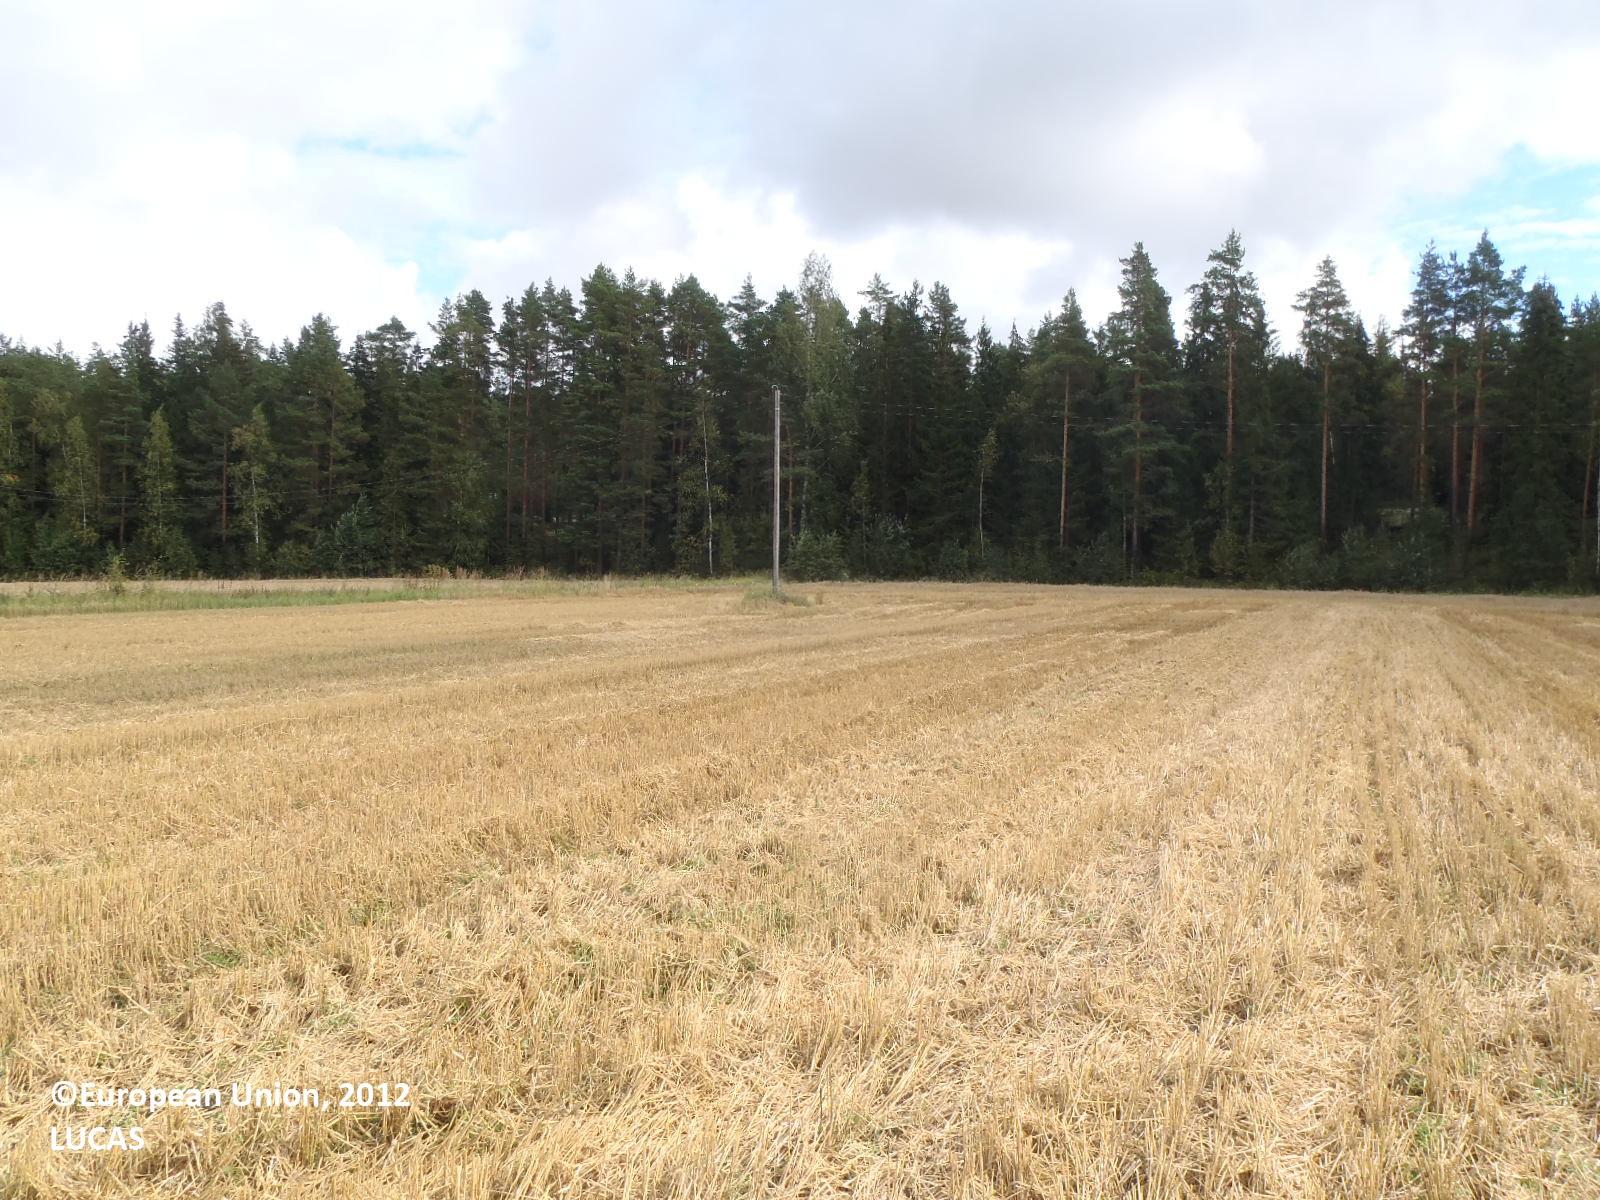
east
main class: Cropland
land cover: Barley
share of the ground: 50 - 75 %
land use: Agriculture (excluding fallow land and kitchen gardens)
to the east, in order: Barley; Grass margins; Ditches and canals; Grass margins; Barley; Electric lines; Barley; Grass margins; Ditches and canals; Grass margins; Paved roads, cycling and walking lanes; Grass margins; Ditches and canals; Pine dominated coniferous woodland; Spruce dominated coniferous woodland
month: September
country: FI
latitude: 61.0603
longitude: 22.7608
